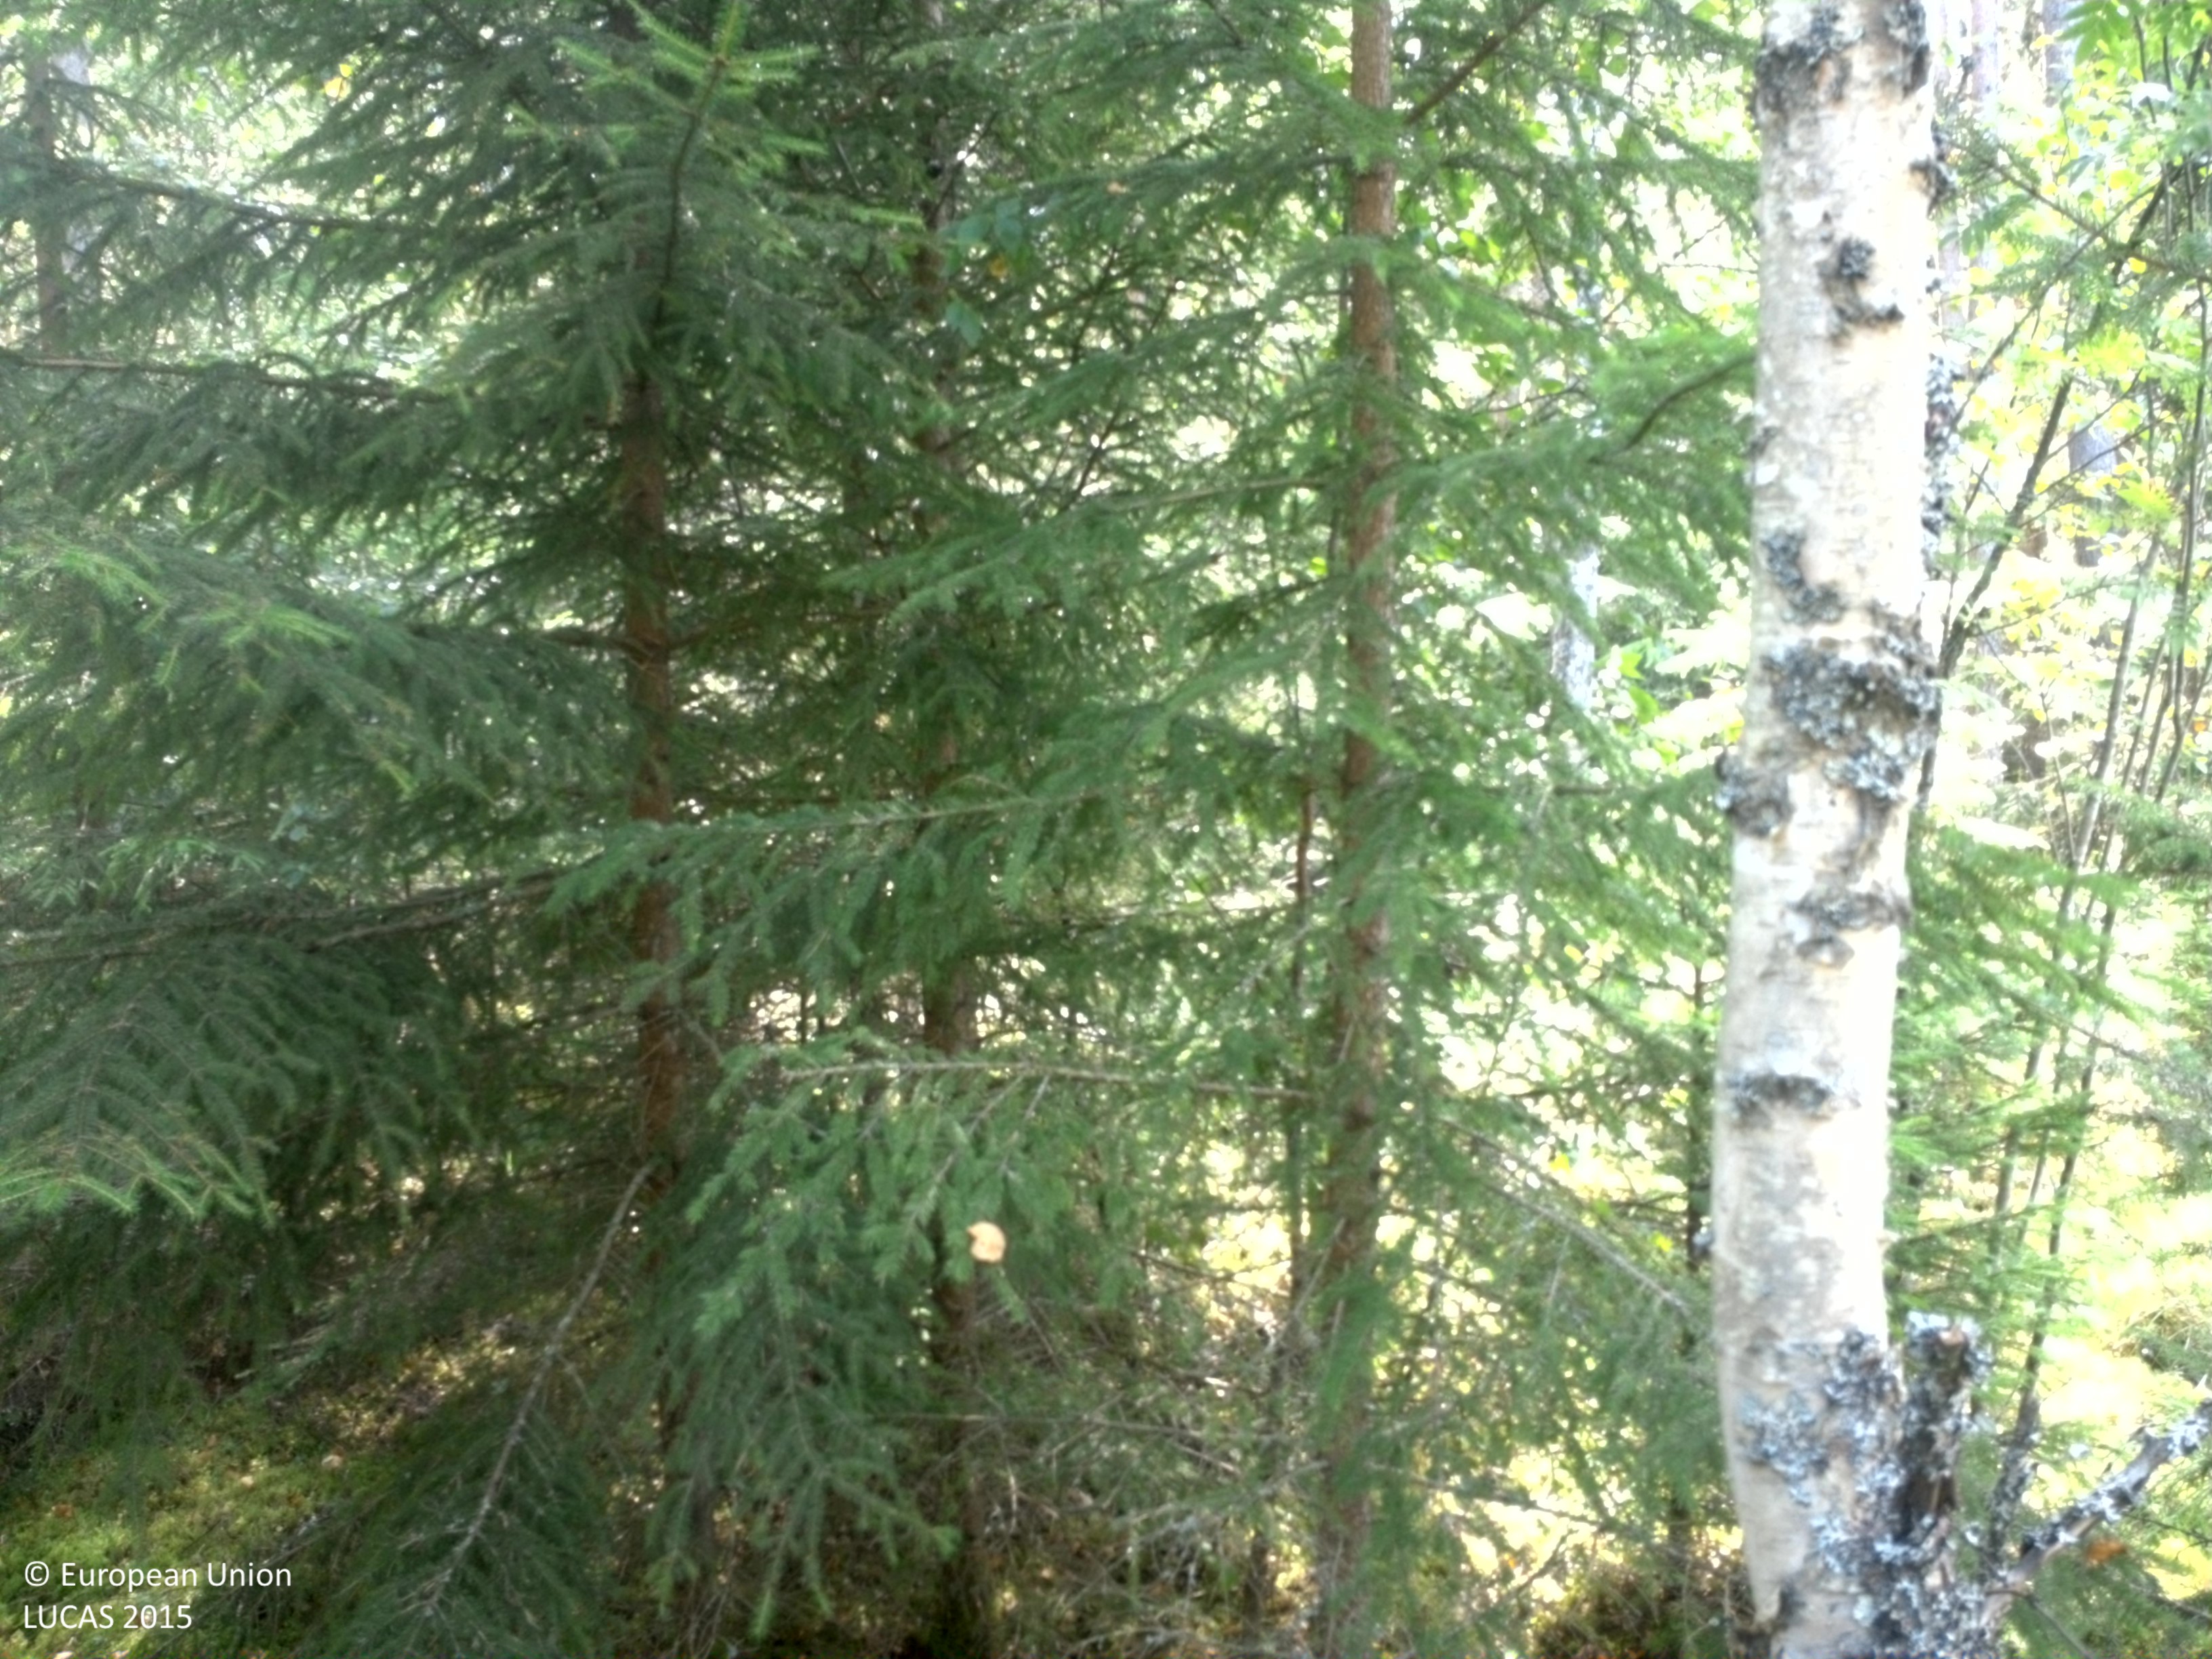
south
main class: Woodland
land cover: Pine dominated mixed woodland
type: boreal forest
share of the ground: 25 - 50 %
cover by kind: coniferous forest trees 30 %, herbaceous plants 30 %, lichens and mosses 25 %, broadleaved forest trees 15 %
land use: Forestry
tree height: > 5 m
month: August
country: SE
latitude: 58.0587
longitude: 13.0624
